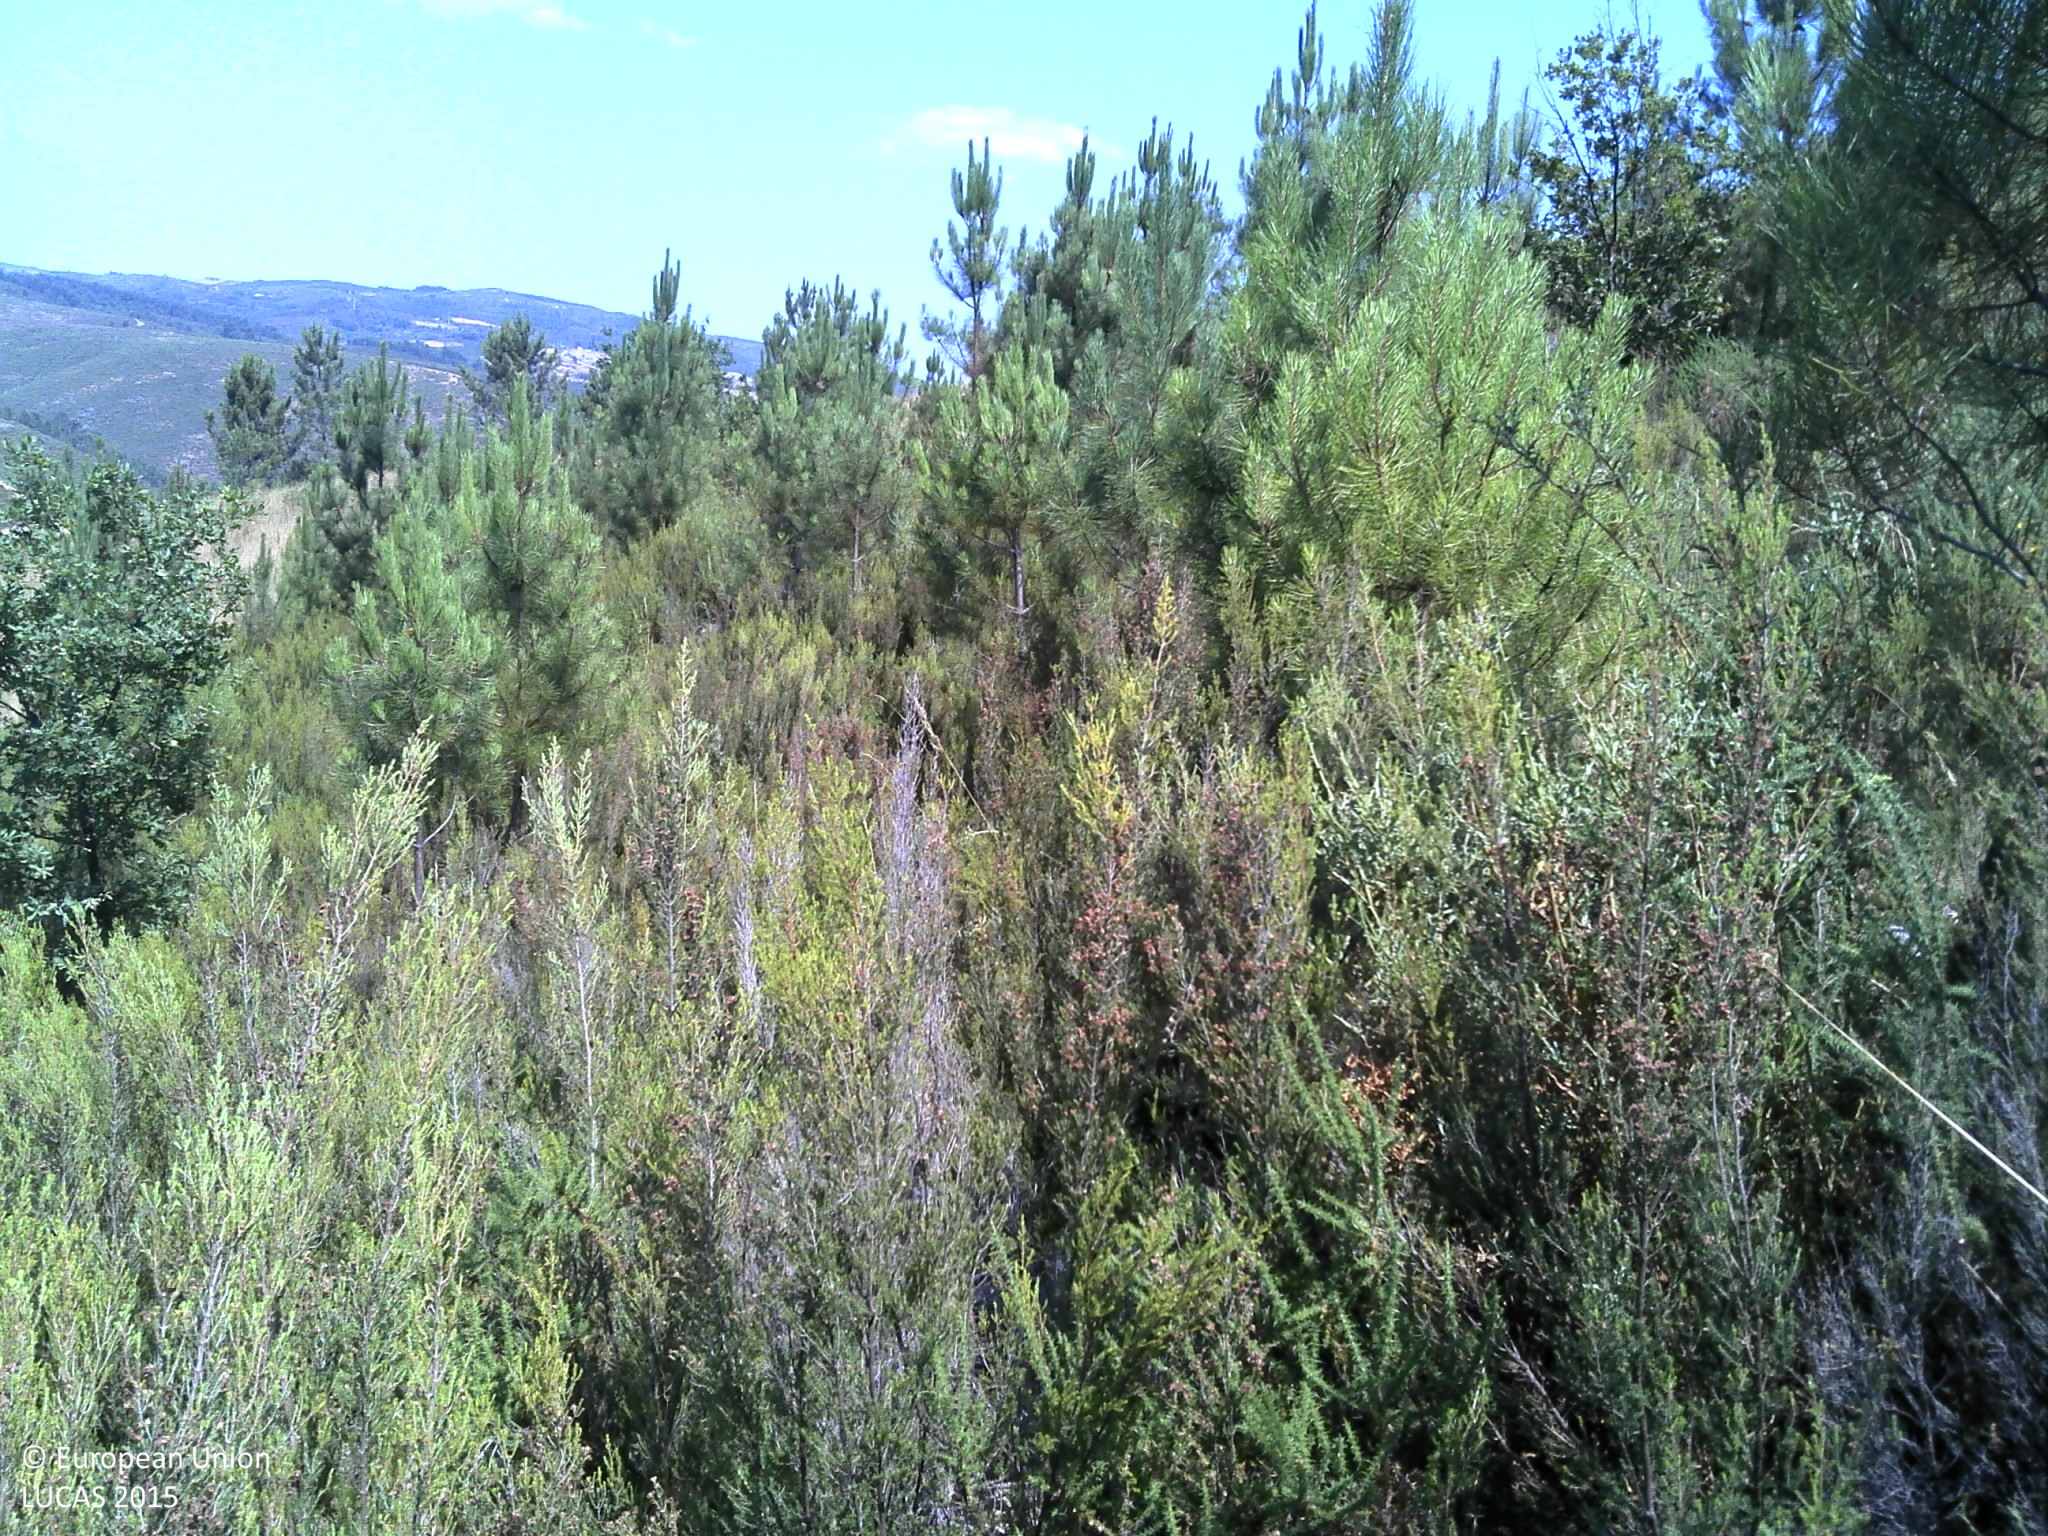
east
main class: Woodland
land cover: Pine dominated coniferous woodland
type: coniferous forest of the mediterranean region
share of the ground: 10 - 25 %
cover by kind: shrubs 85 %, coniferous forest trees 15 %
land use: Forestry
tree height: < 5 m
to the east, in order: Pine dominated coniferous woodland; Grassland with sparse tree/shrub cover; Pine dominated coniferous woodland; Rivers and streams; Pine dominated coniferous woodland; Grassland with sparse tree/shrub cover; Pine dominated coniferous woodland
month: July
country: PT
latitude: 40.8485
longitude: -7.8589
